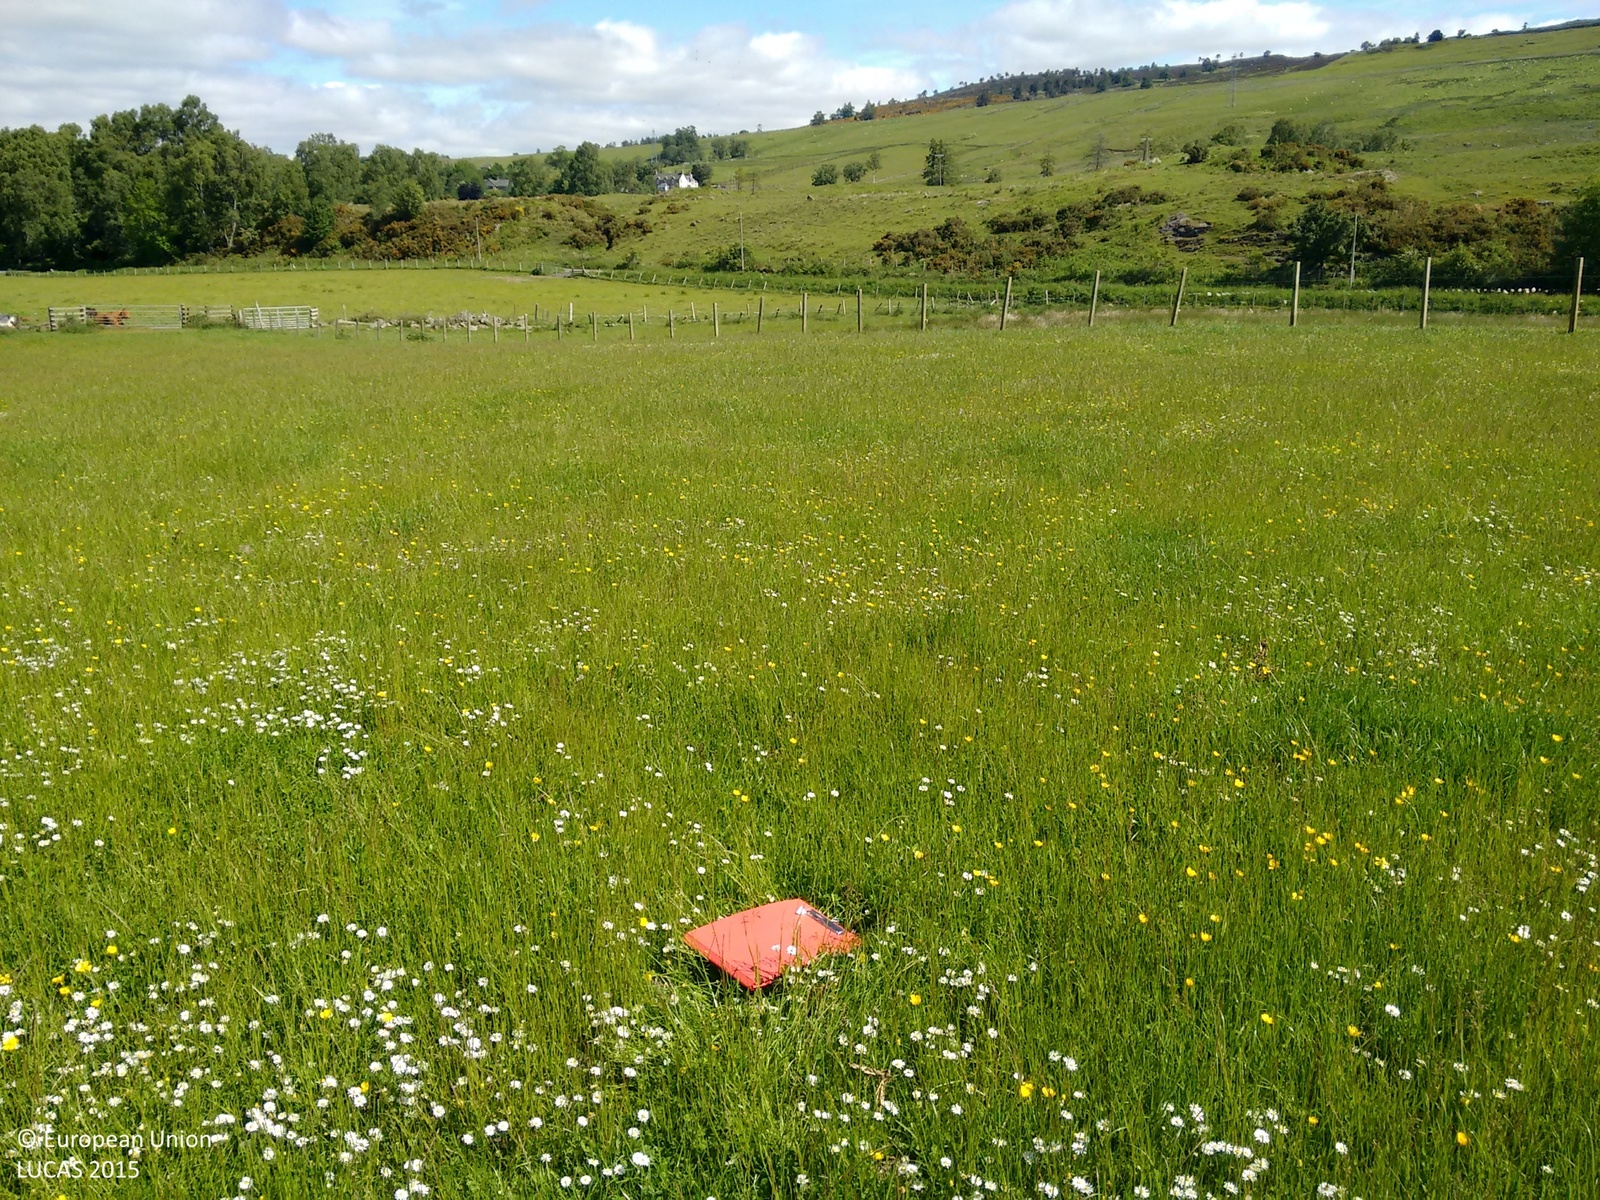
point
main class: Grassland
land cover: Grassland without tree/shrub cover
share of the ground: > 75 %
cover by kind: herbaceous plants 100 %
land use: Agriculture (excluding fallow land and kitchen gardens)
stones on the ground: < 10 %
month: June
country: GB
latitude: 56.6435
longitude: -3.6281
